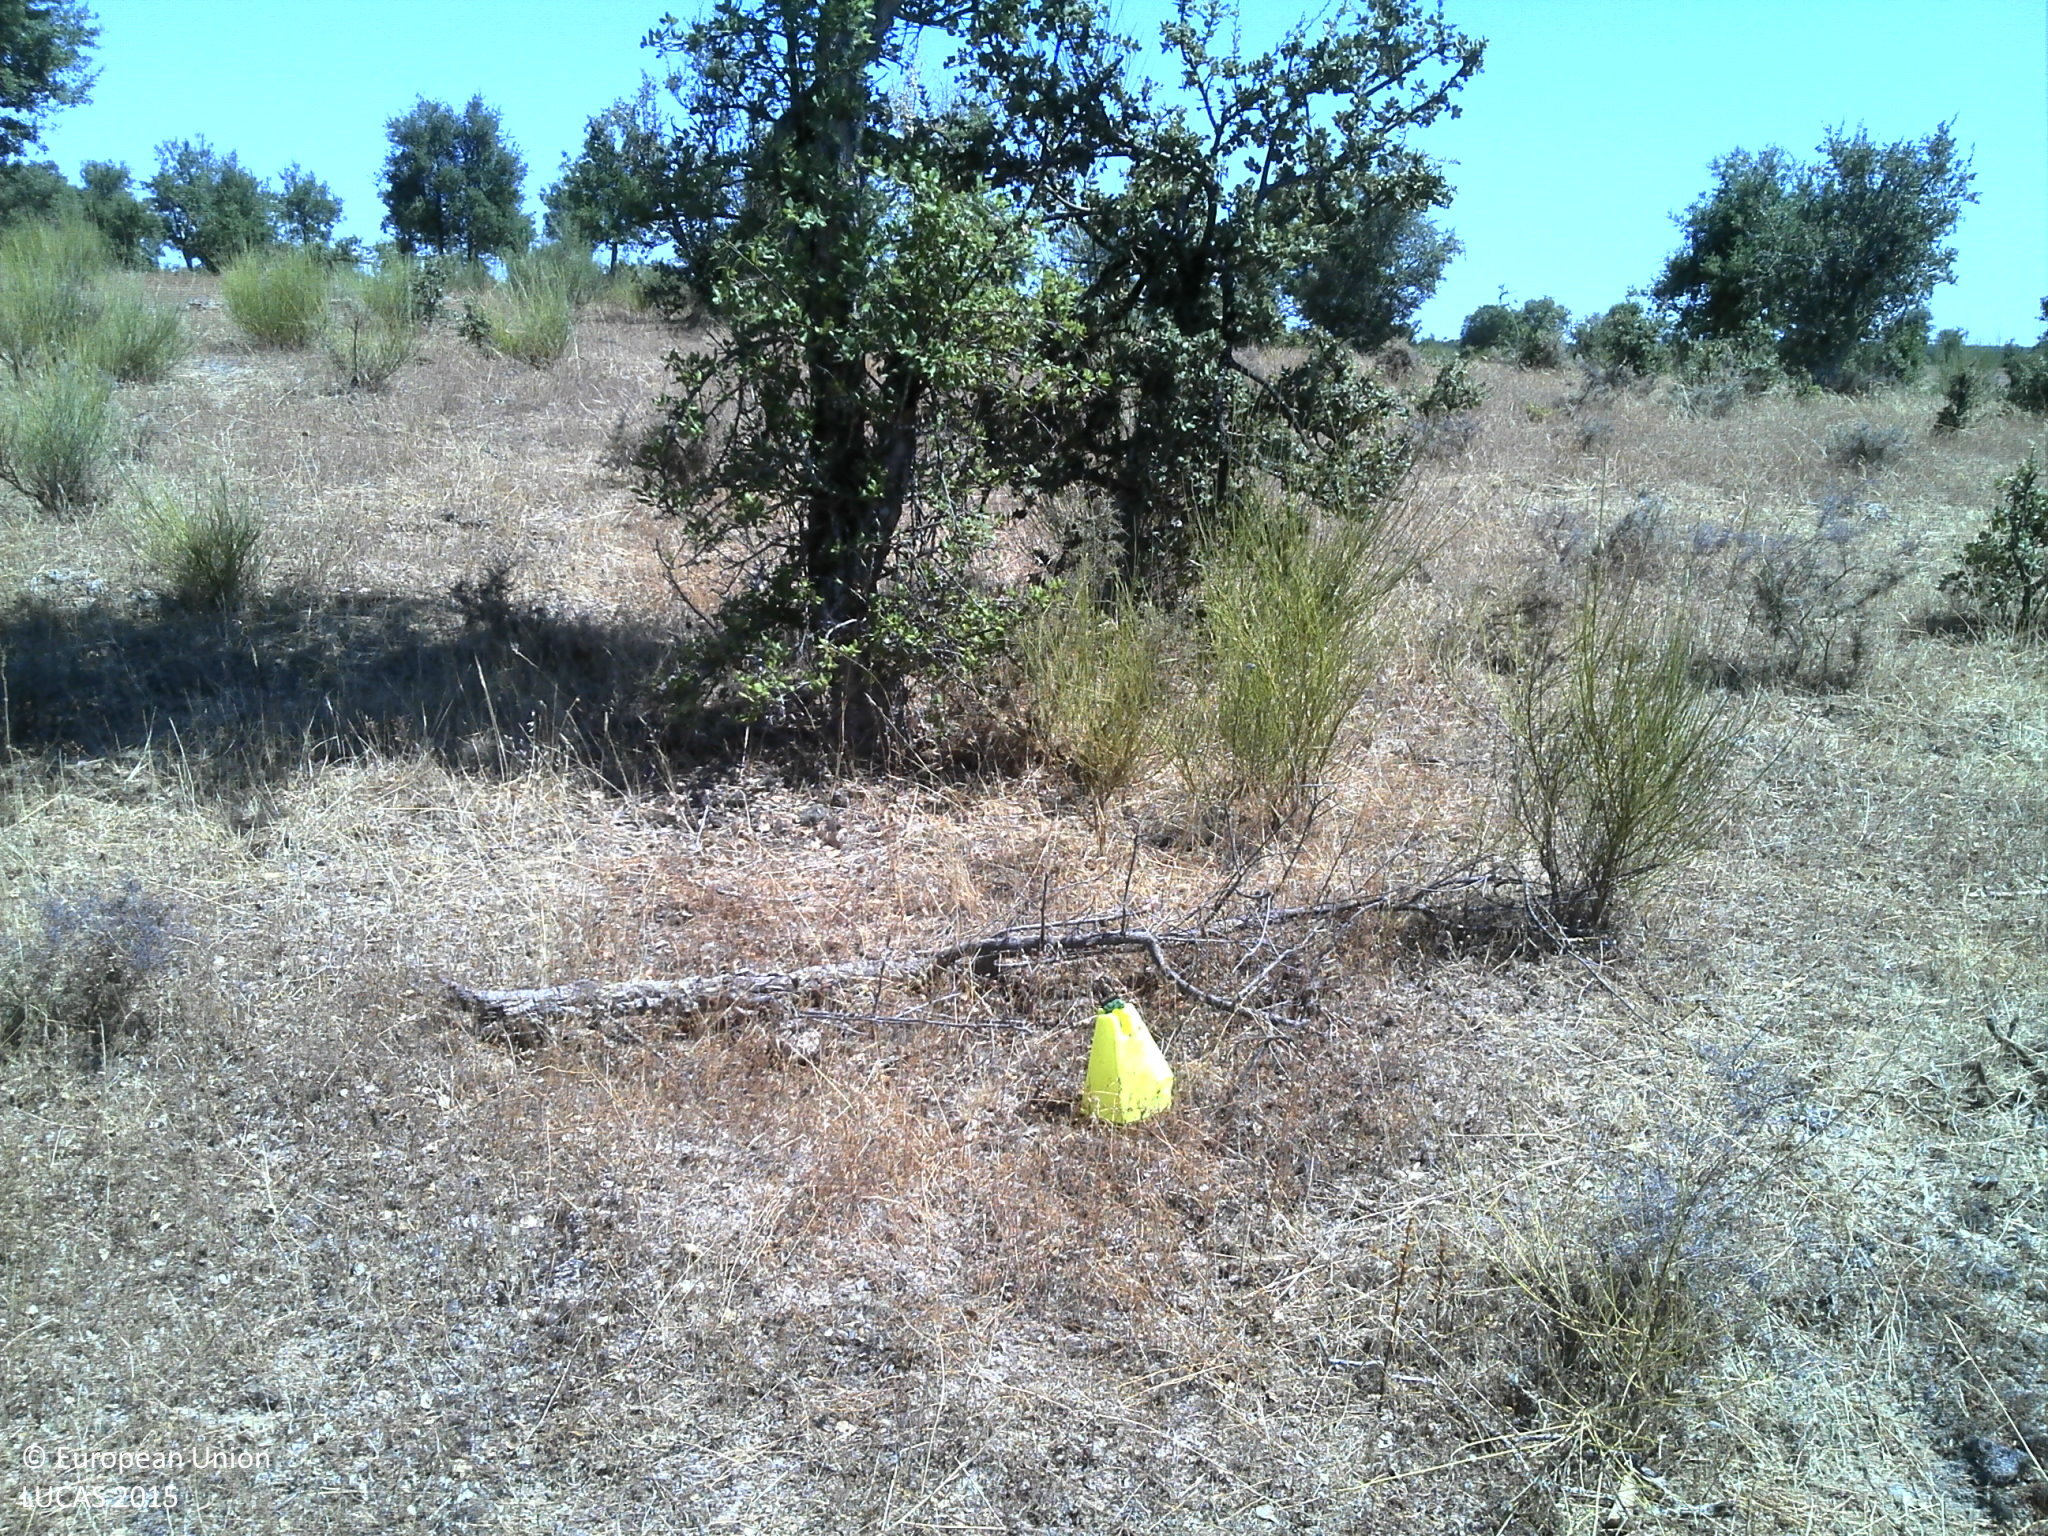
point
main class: Woodland
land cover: Broadleaved woodland
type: broadleaved evergreen forest
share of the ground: 10 - 25 %
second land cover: Grassland without tree/shrub cover
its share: 10 - 25 %
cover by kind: unconsolidated bare surface 75 %, broadleaved forest trees 10 %, herbaceous plants 10 %, shrubs 5 %
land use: Forestry
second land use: Agriculture (excluding fallow land and kitchen gardens)
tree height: > 5 m
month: July
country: PT
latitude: 39.3676
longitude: -7.6798
